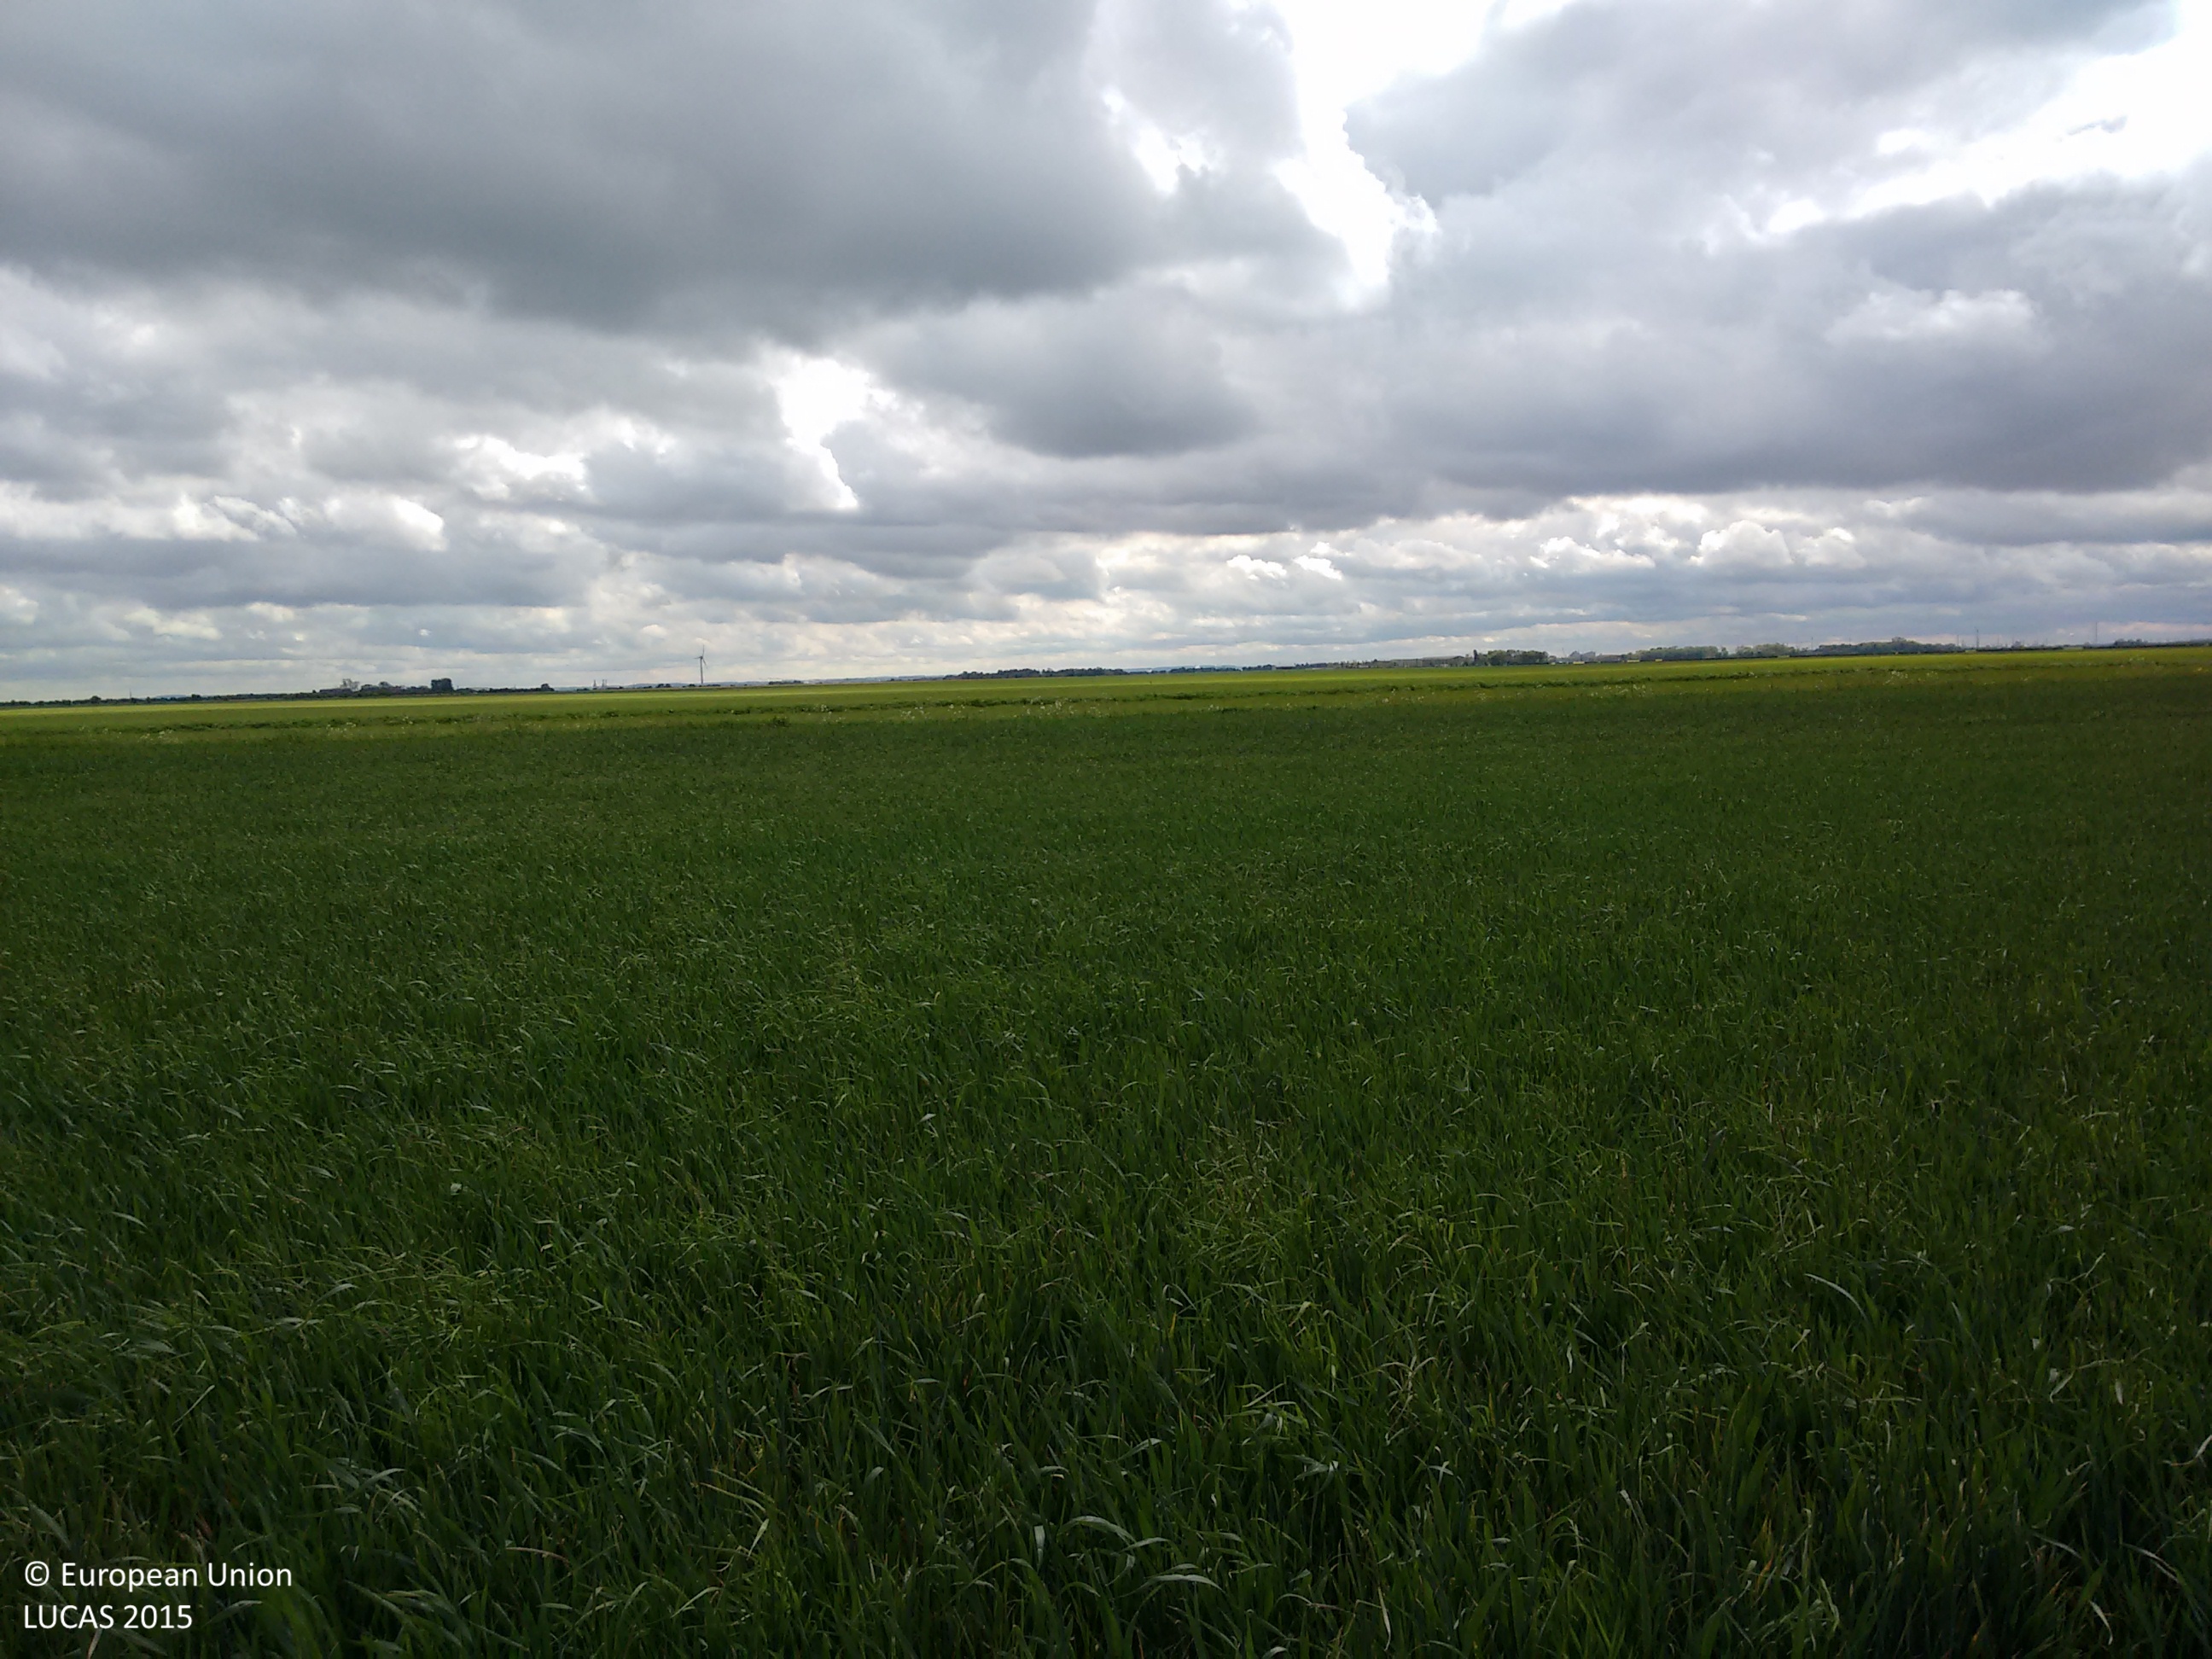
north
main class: Cropland
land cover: Common wheat
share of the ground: > 75 %
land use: Agriculture (excluding fallow land and kitchen gardens)
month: May
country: GB
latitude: 53.7031
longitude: -0.1060
